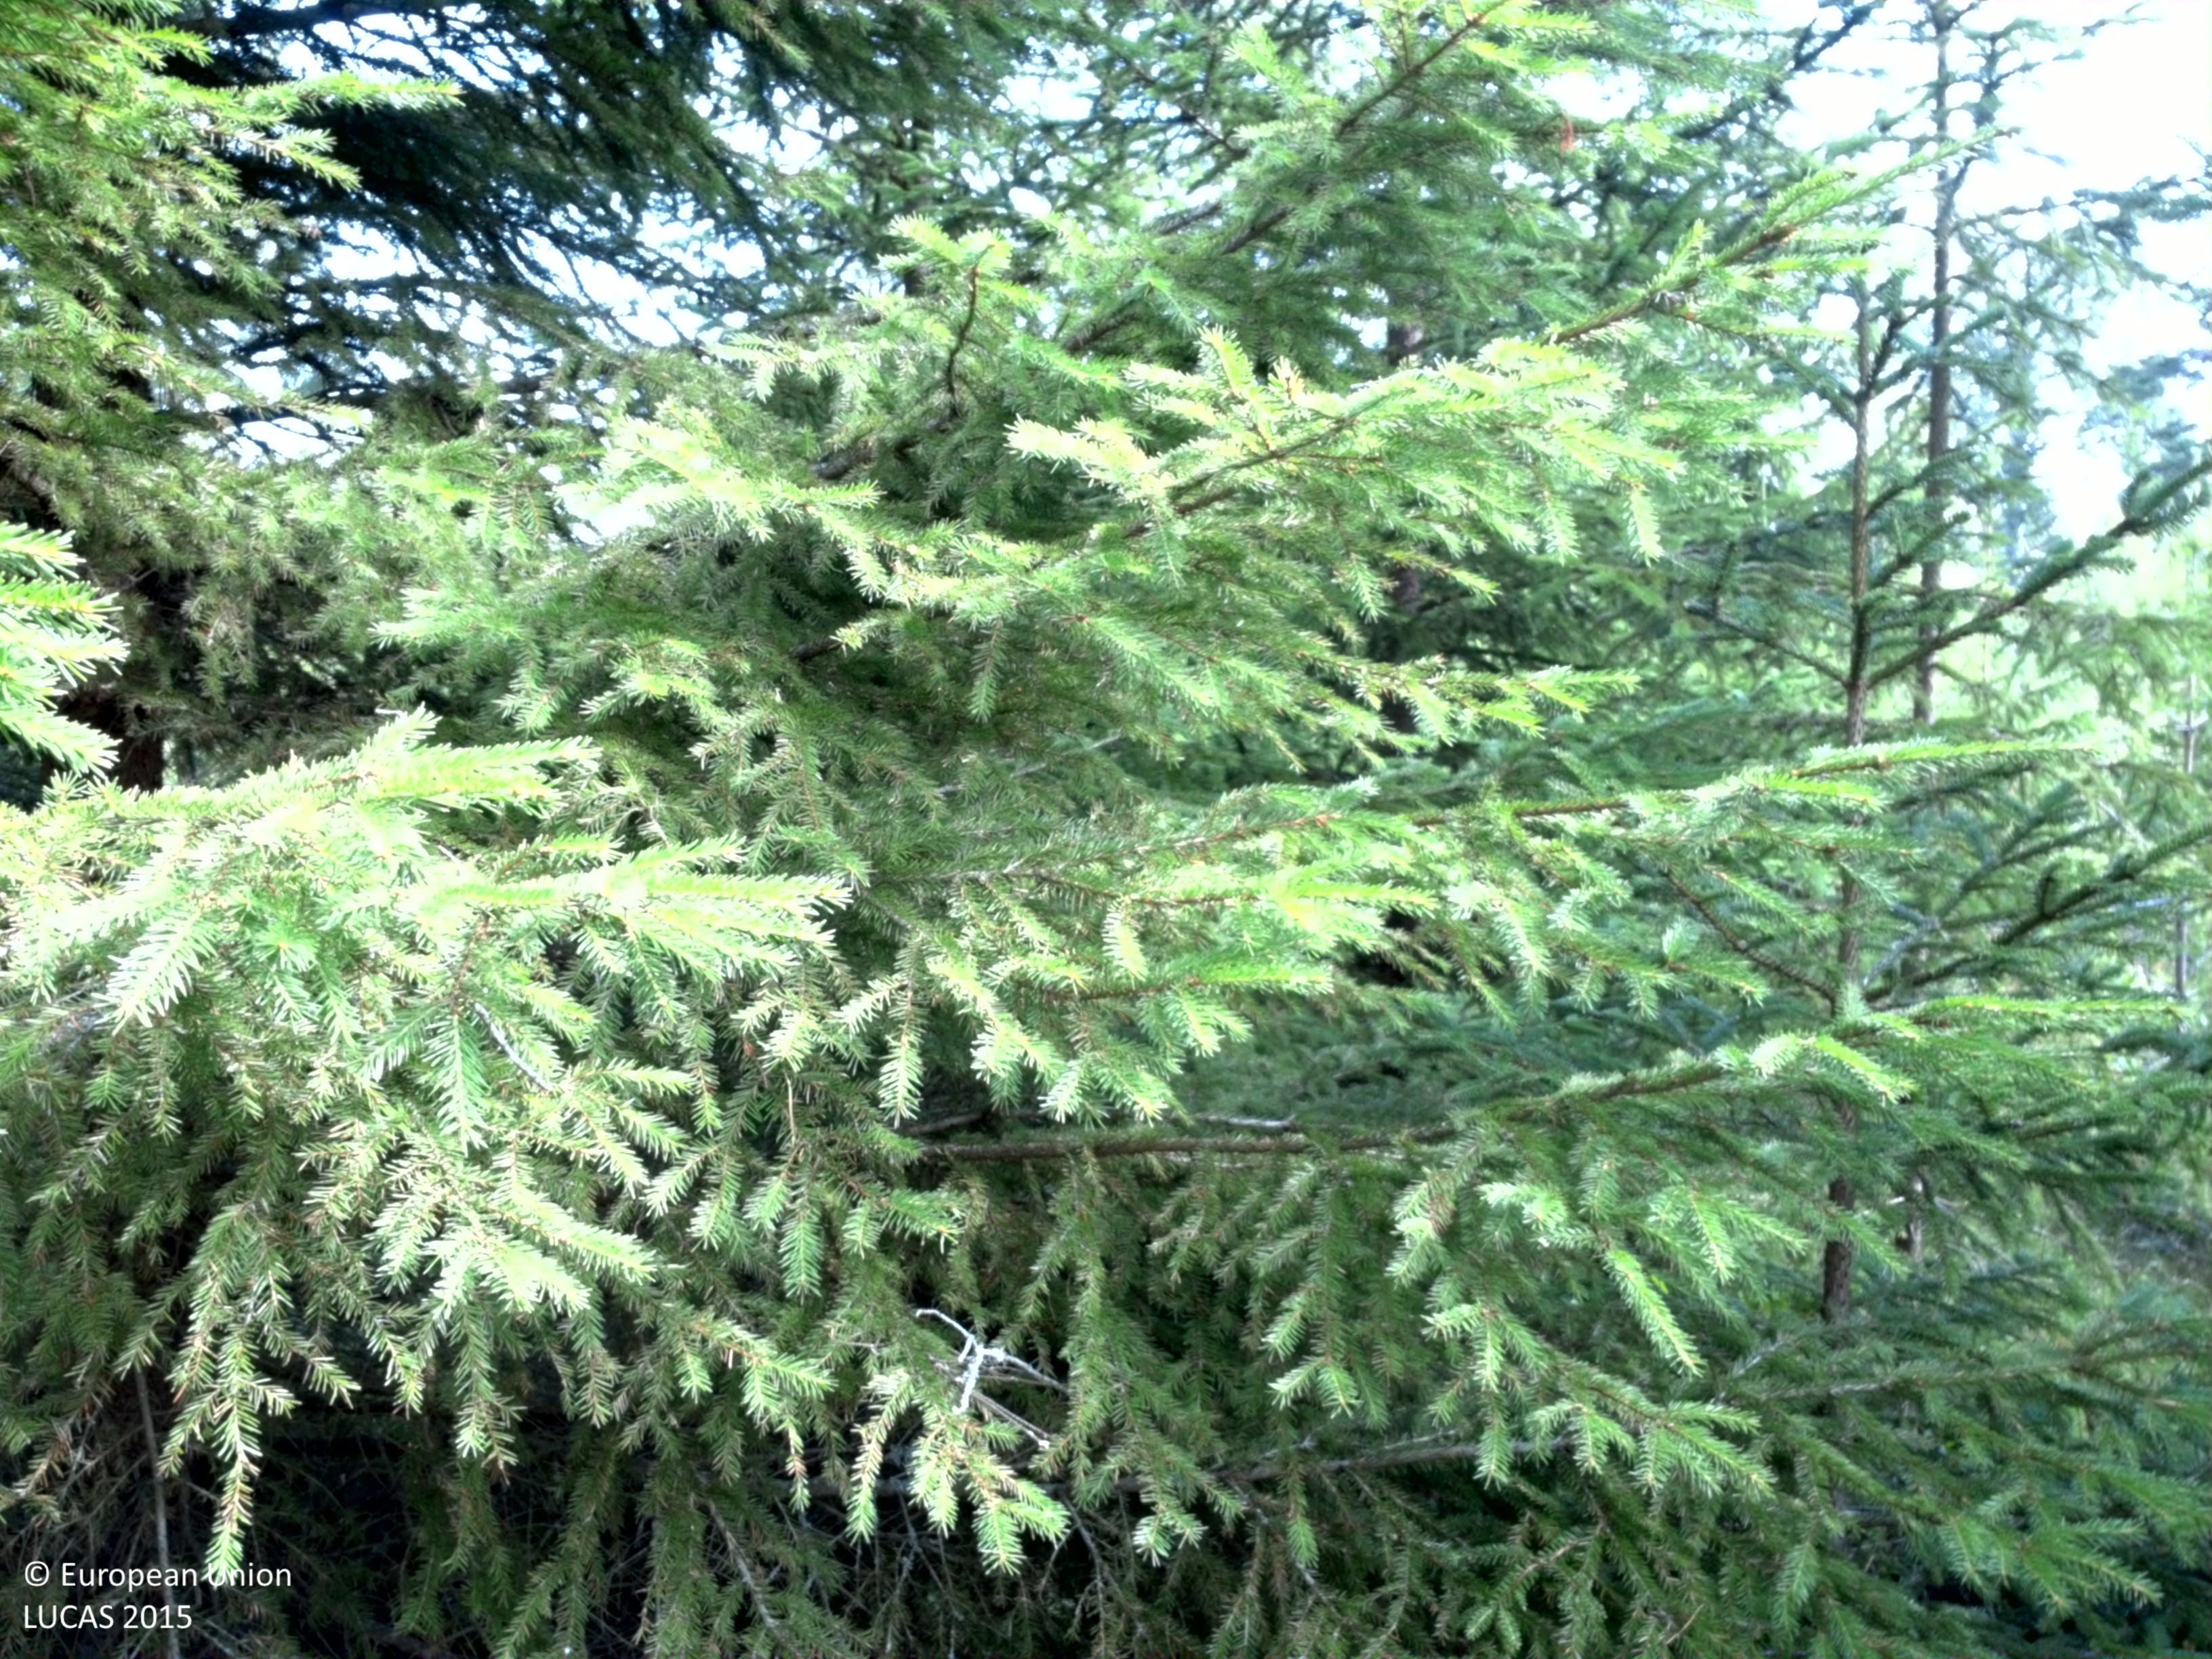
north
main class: Woodland
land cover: Spruce dominated mixed woodland
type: boreal forest
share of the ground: 50 - 75 %
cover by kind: coniferous forest trees 45 %, lichens and mosses 30 %, broadleaved forest trees 15 %, shrubs 10 %
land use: Forestry
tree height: > 5 m
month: July
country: SE
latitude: 60.0003
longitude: 18.7310
